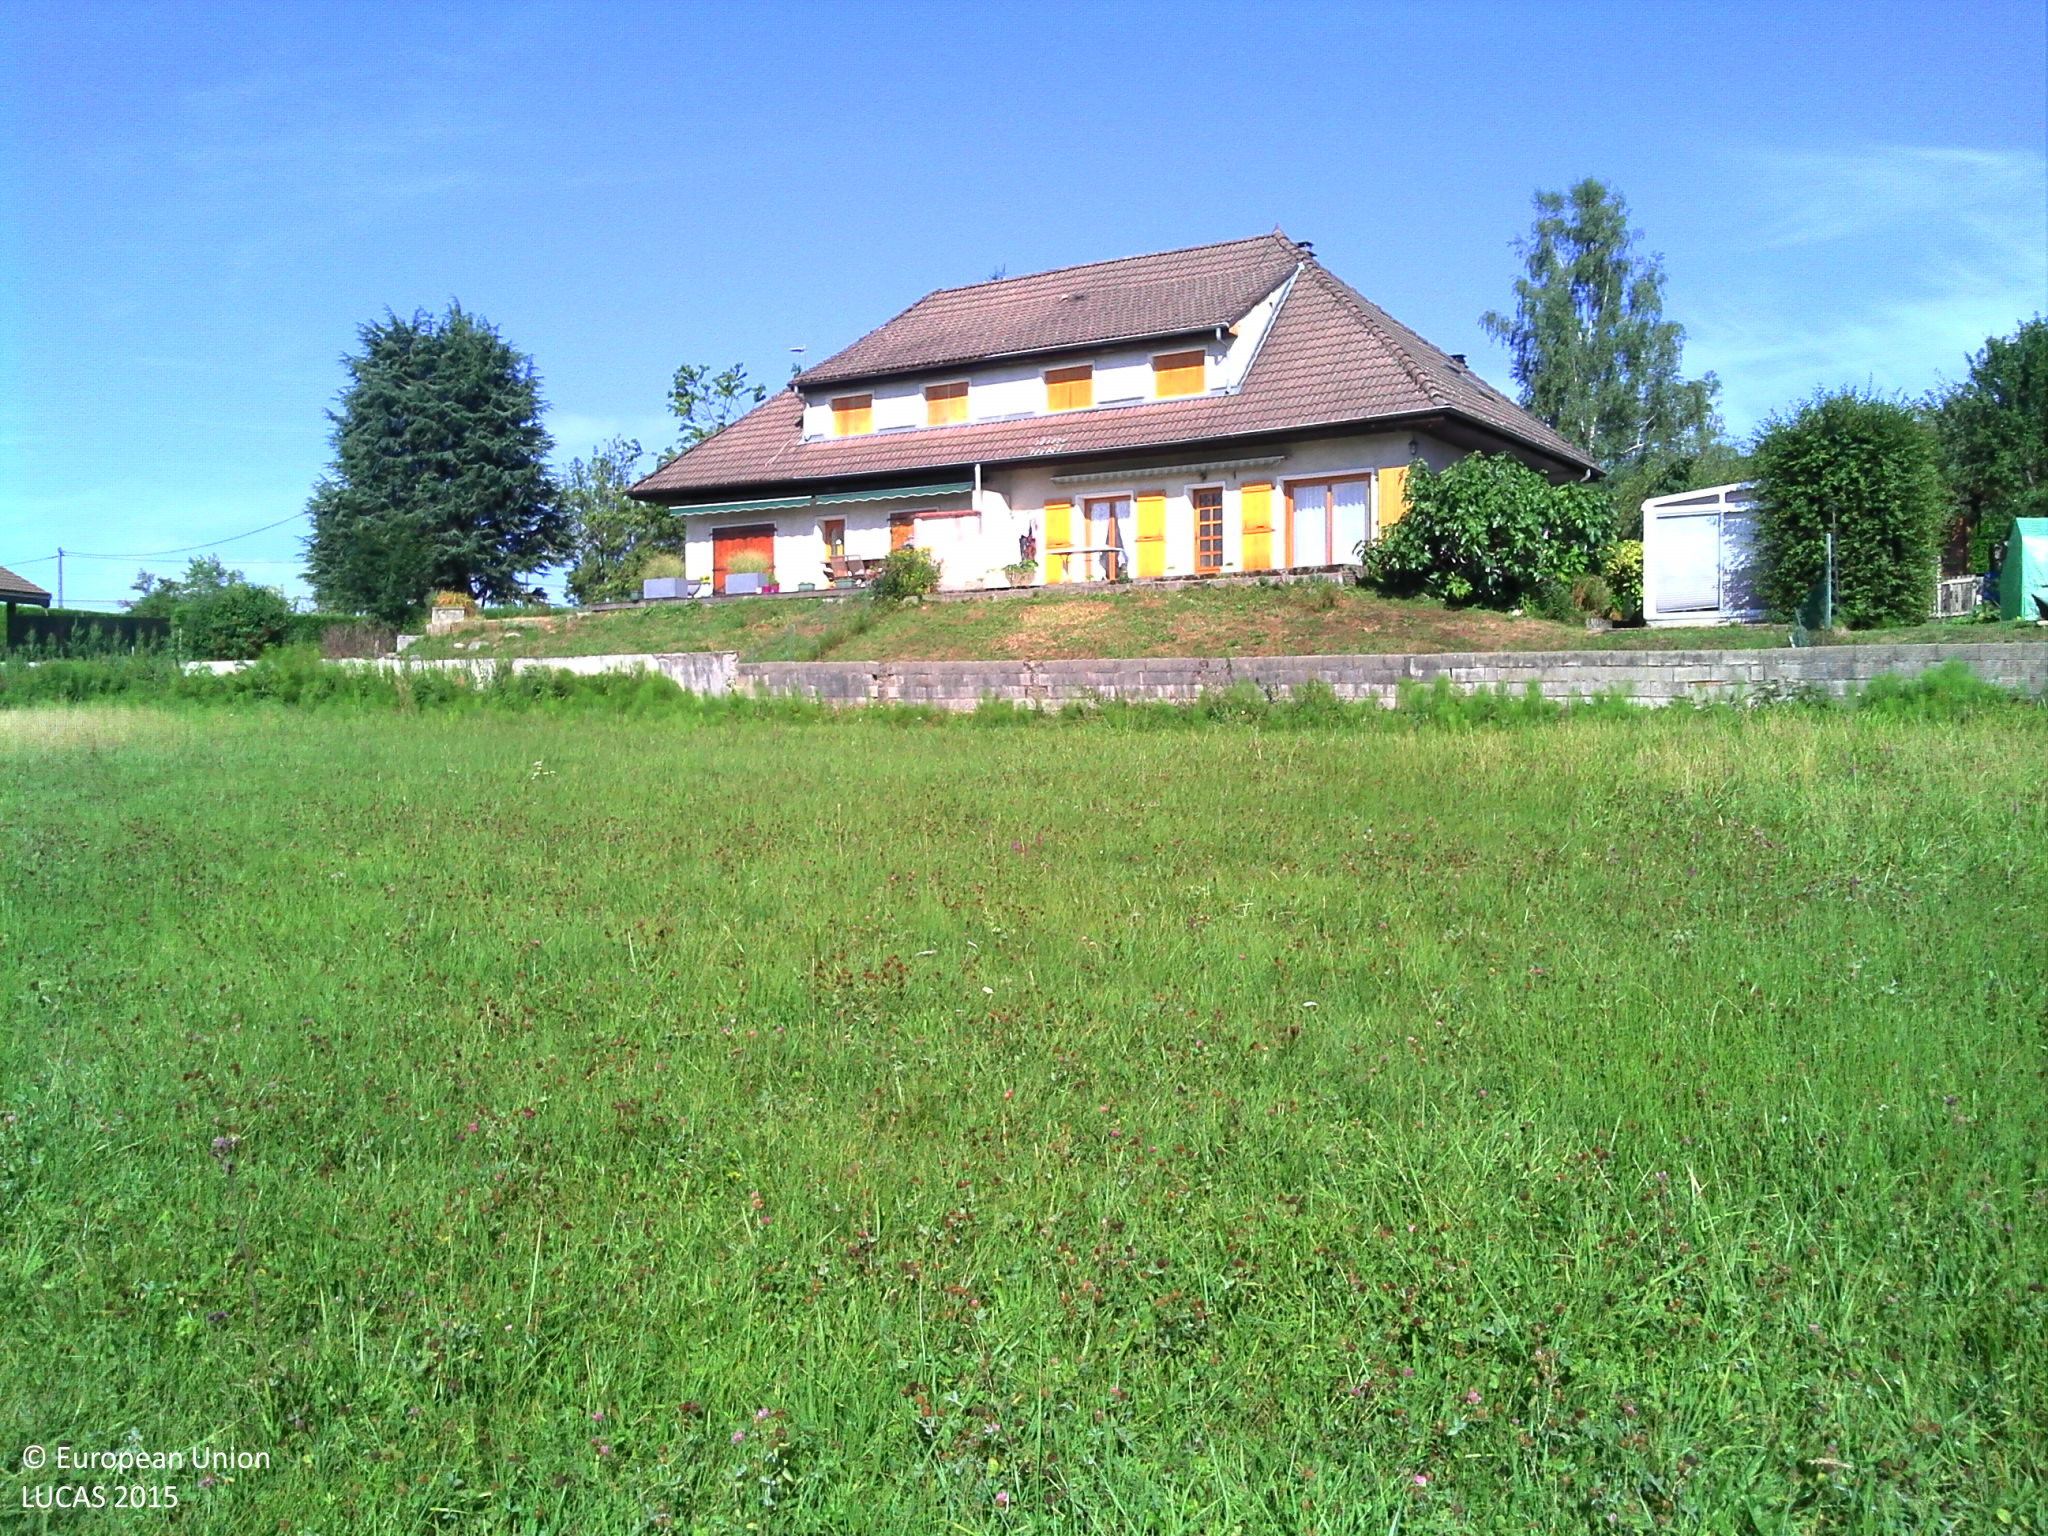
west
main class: Grassland
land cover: Grassland without tree/shrub cover
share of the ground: > 75 %
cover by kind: herbaceous plants 100 %
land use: Agriculture (excluding fallow land and kitchen gardens)
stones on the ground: < 10 %
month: July
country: FR
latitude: 45.9752
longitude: 6.1448
